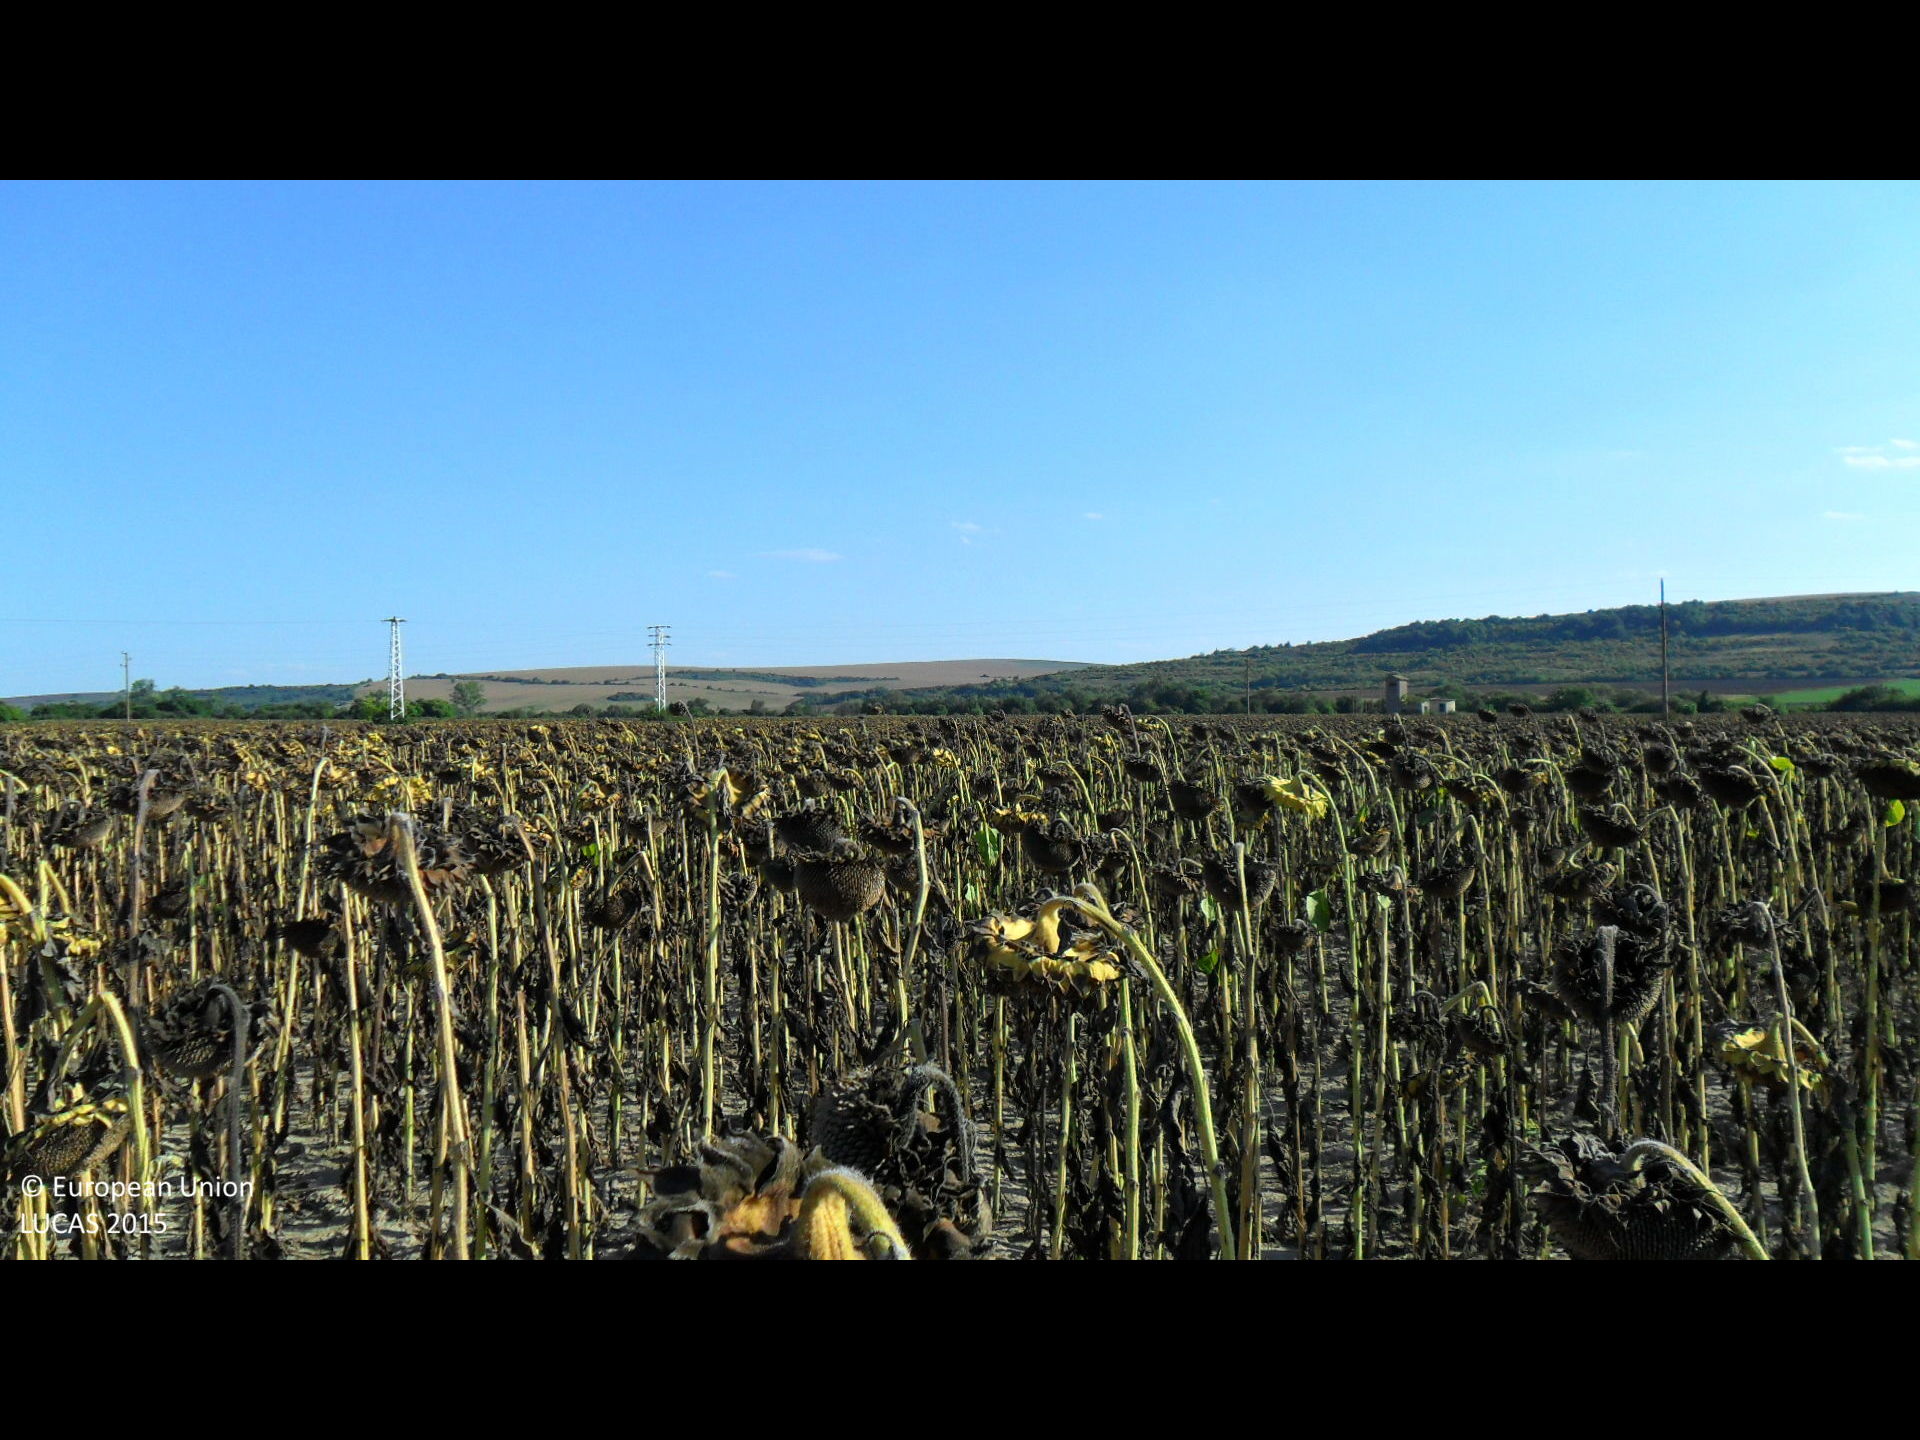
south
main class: Cropland
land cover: Sunflower
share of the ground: > 75 %
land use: Agriculture (excluding fallow land and kitchen gardens)
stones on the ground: < 10 %
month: August
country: BG
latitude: 43.4728
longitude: 26.3061
